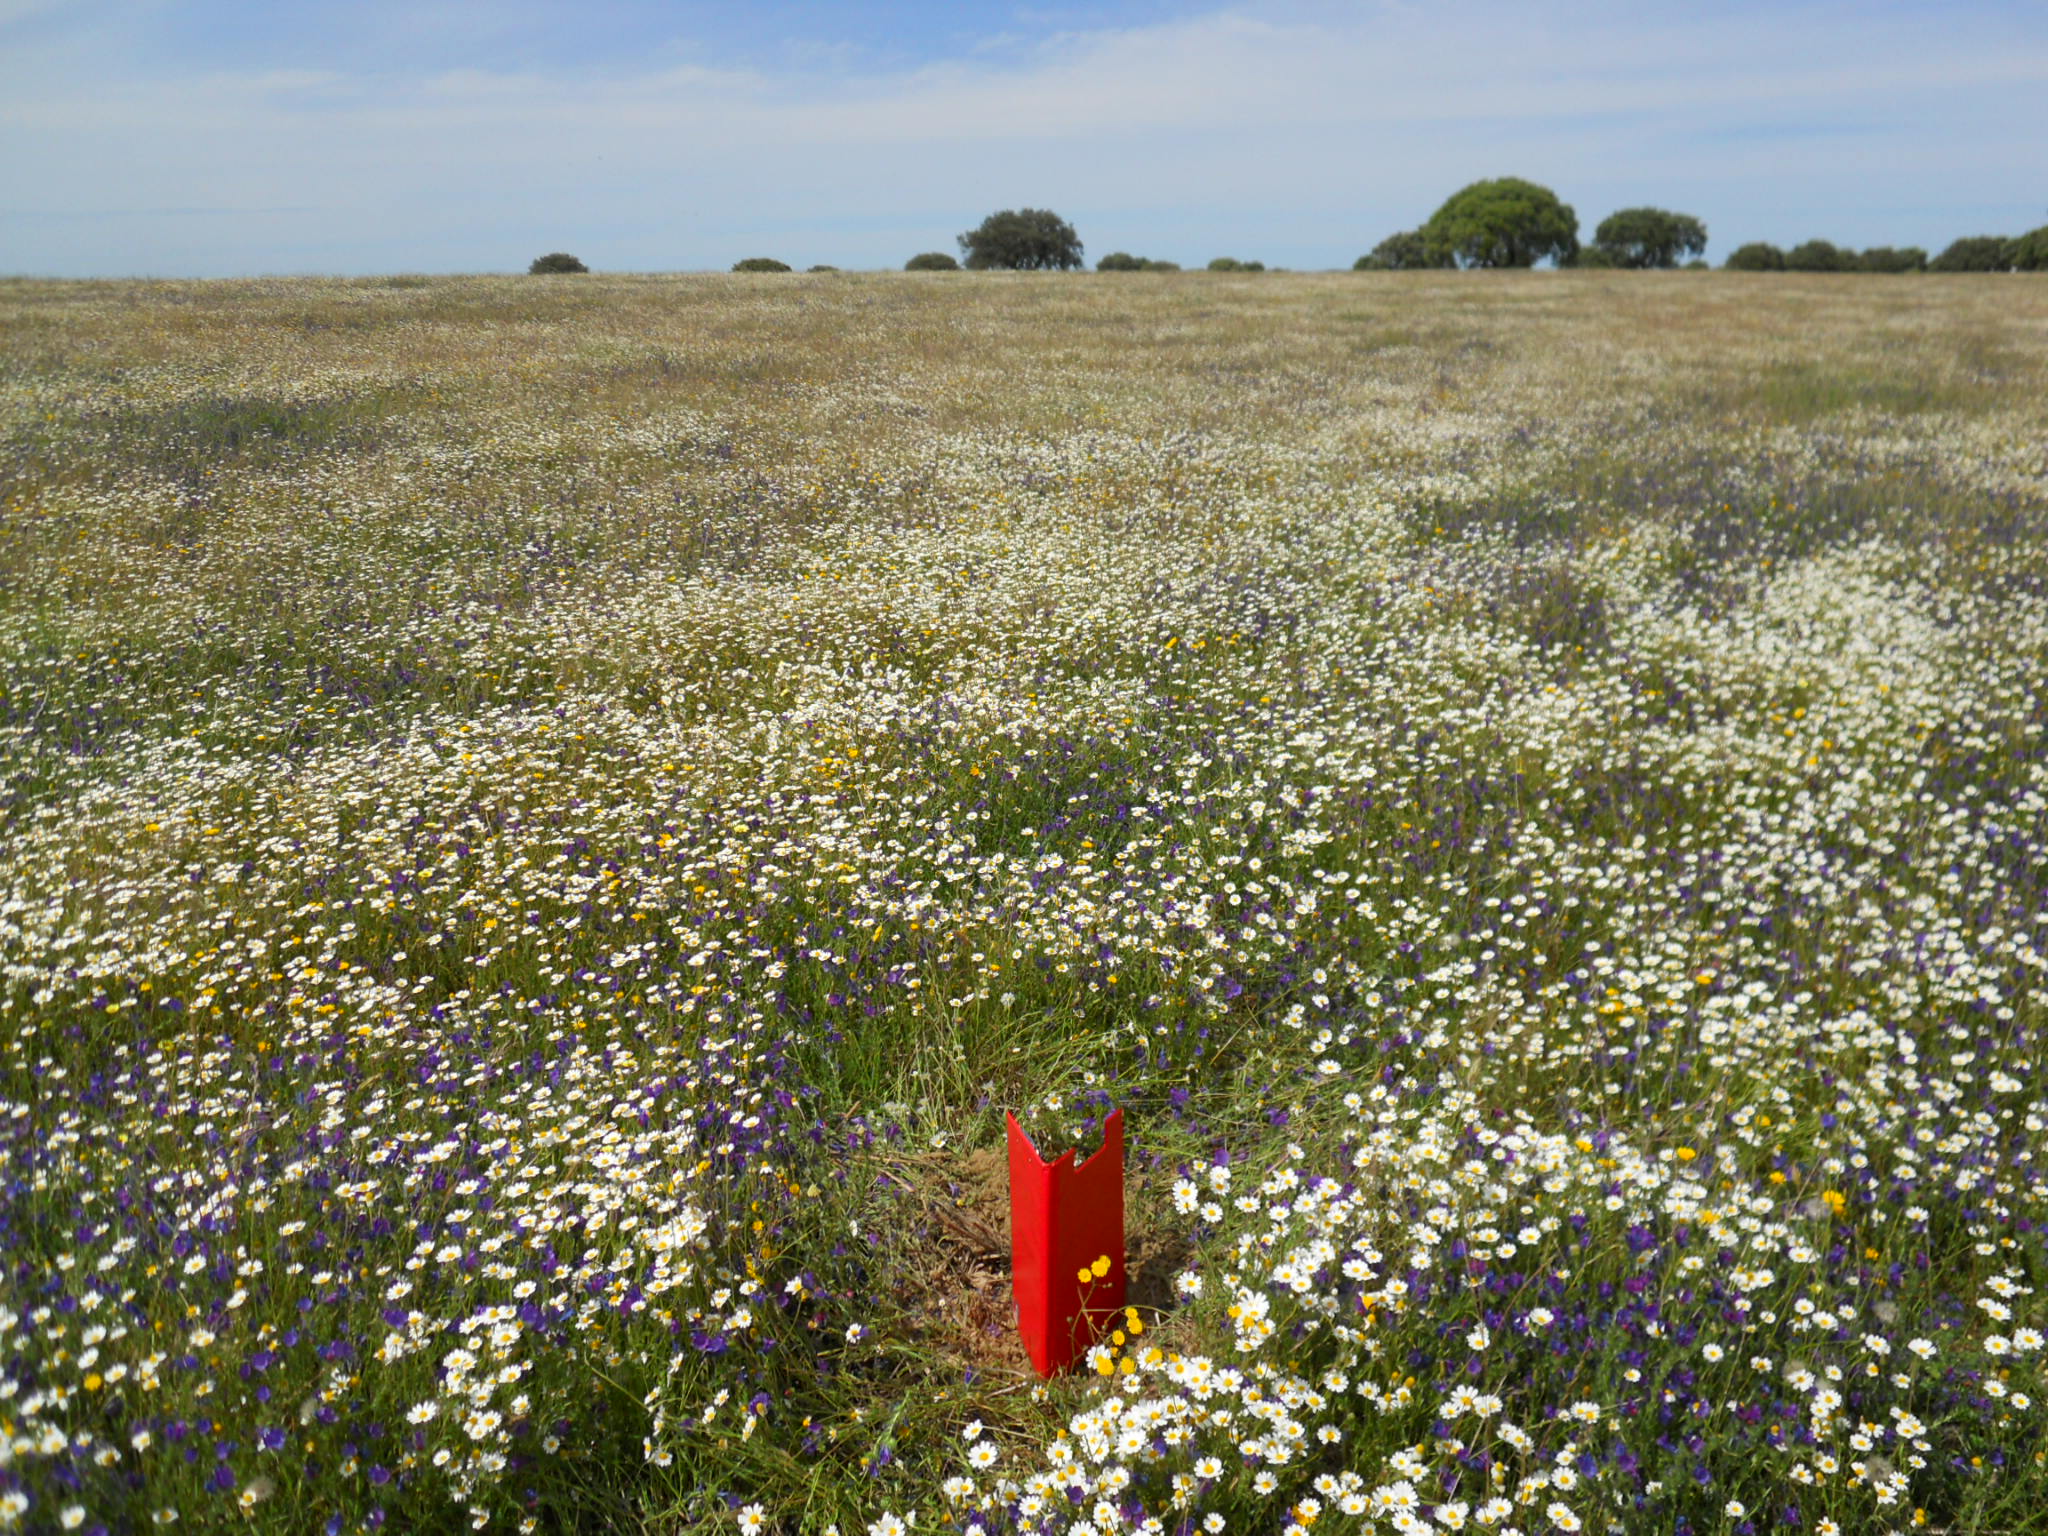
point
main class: Grassland
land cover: Spontaneously vegetated surfaces
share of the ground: > 75 %
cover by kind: herbaceous plants 100 %
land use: Agriculture (excluding fallow land and kitchen gardens)
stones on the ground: < 10 %
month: May
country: ES
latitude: 39.3251
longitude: -6.3631
